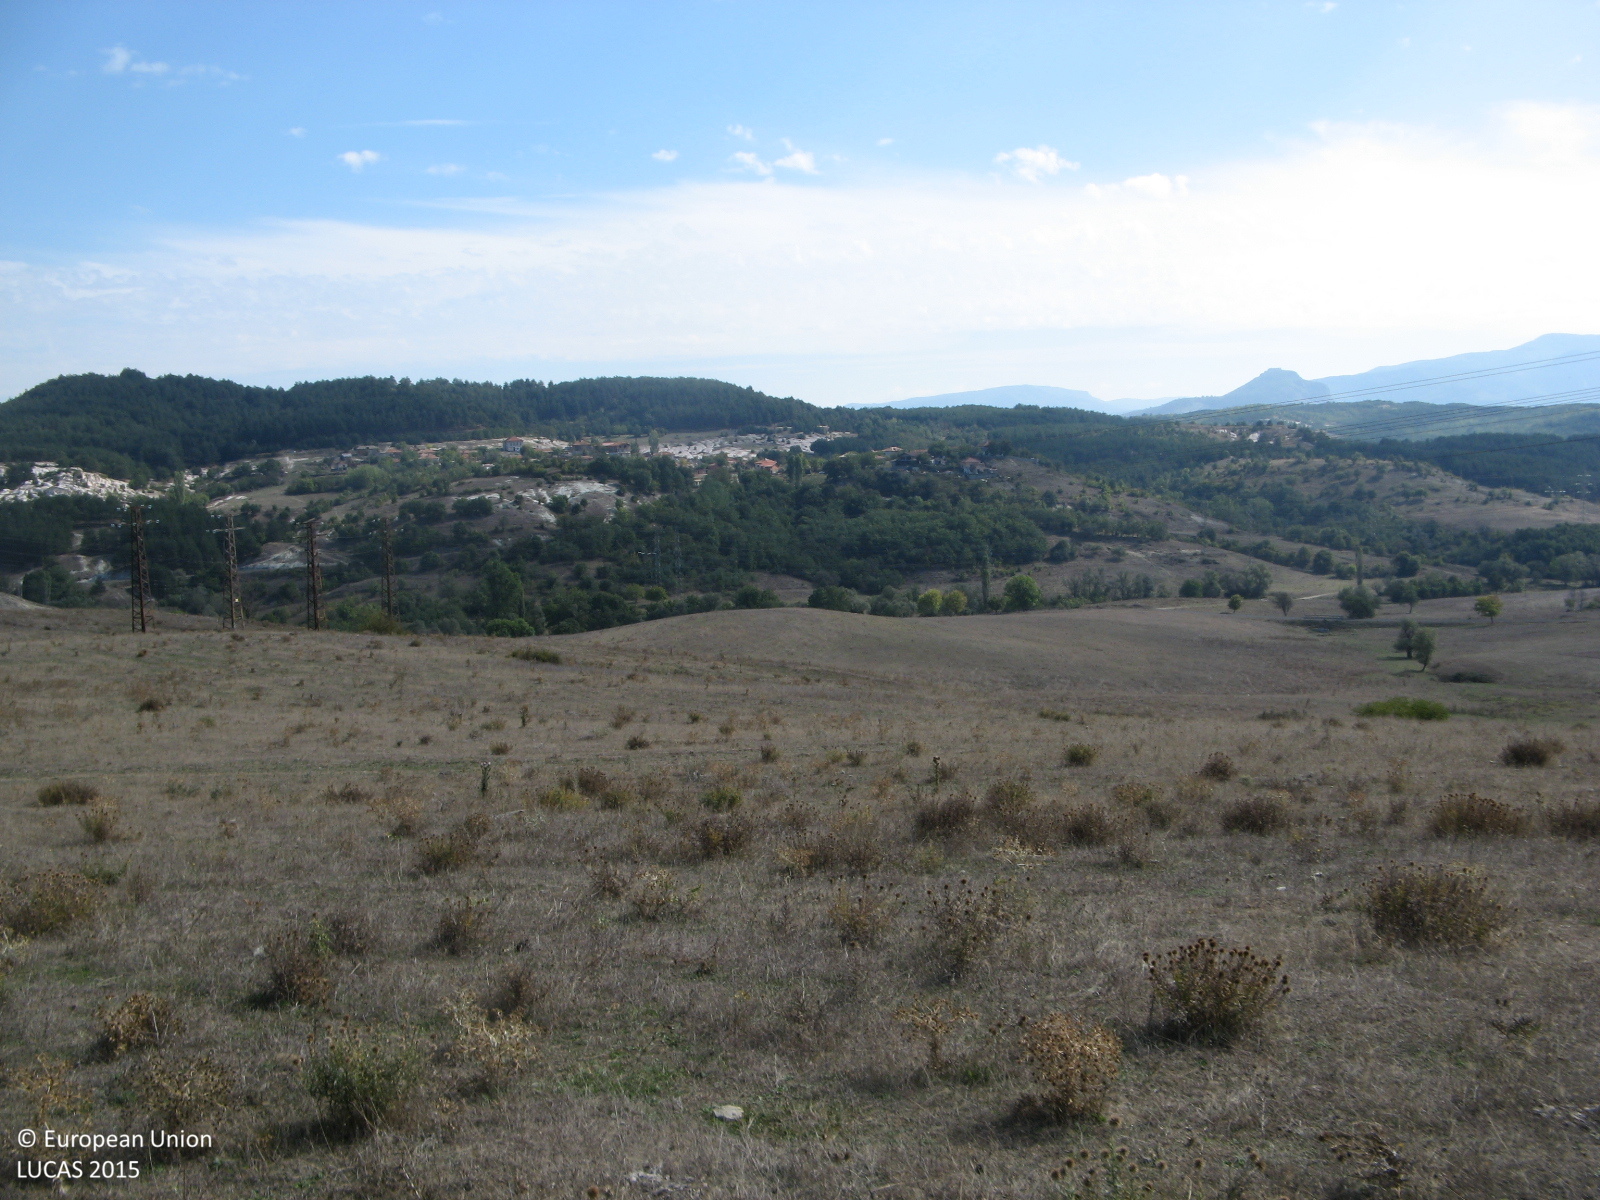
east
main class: Grassland
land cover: Grassland without tree/shrub cover
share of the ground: > 75 %
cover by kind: herbaceous plants 100 %
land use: Agriculture (excluding fallow land and kitchen gardens)
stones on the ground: < 10 %
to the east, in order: Grassland without tree/shrub cover; Tracks; Grassland without tree/shrub cover; Electric lines; Grassland without tree/shrub cover; Electric lines; Grassland without tree/shrub cover; Electric lines; Shrubland without tree cover; Grassland without tree/shrub cover
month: October
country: BG
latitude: 41.6530
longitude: 25.3913
